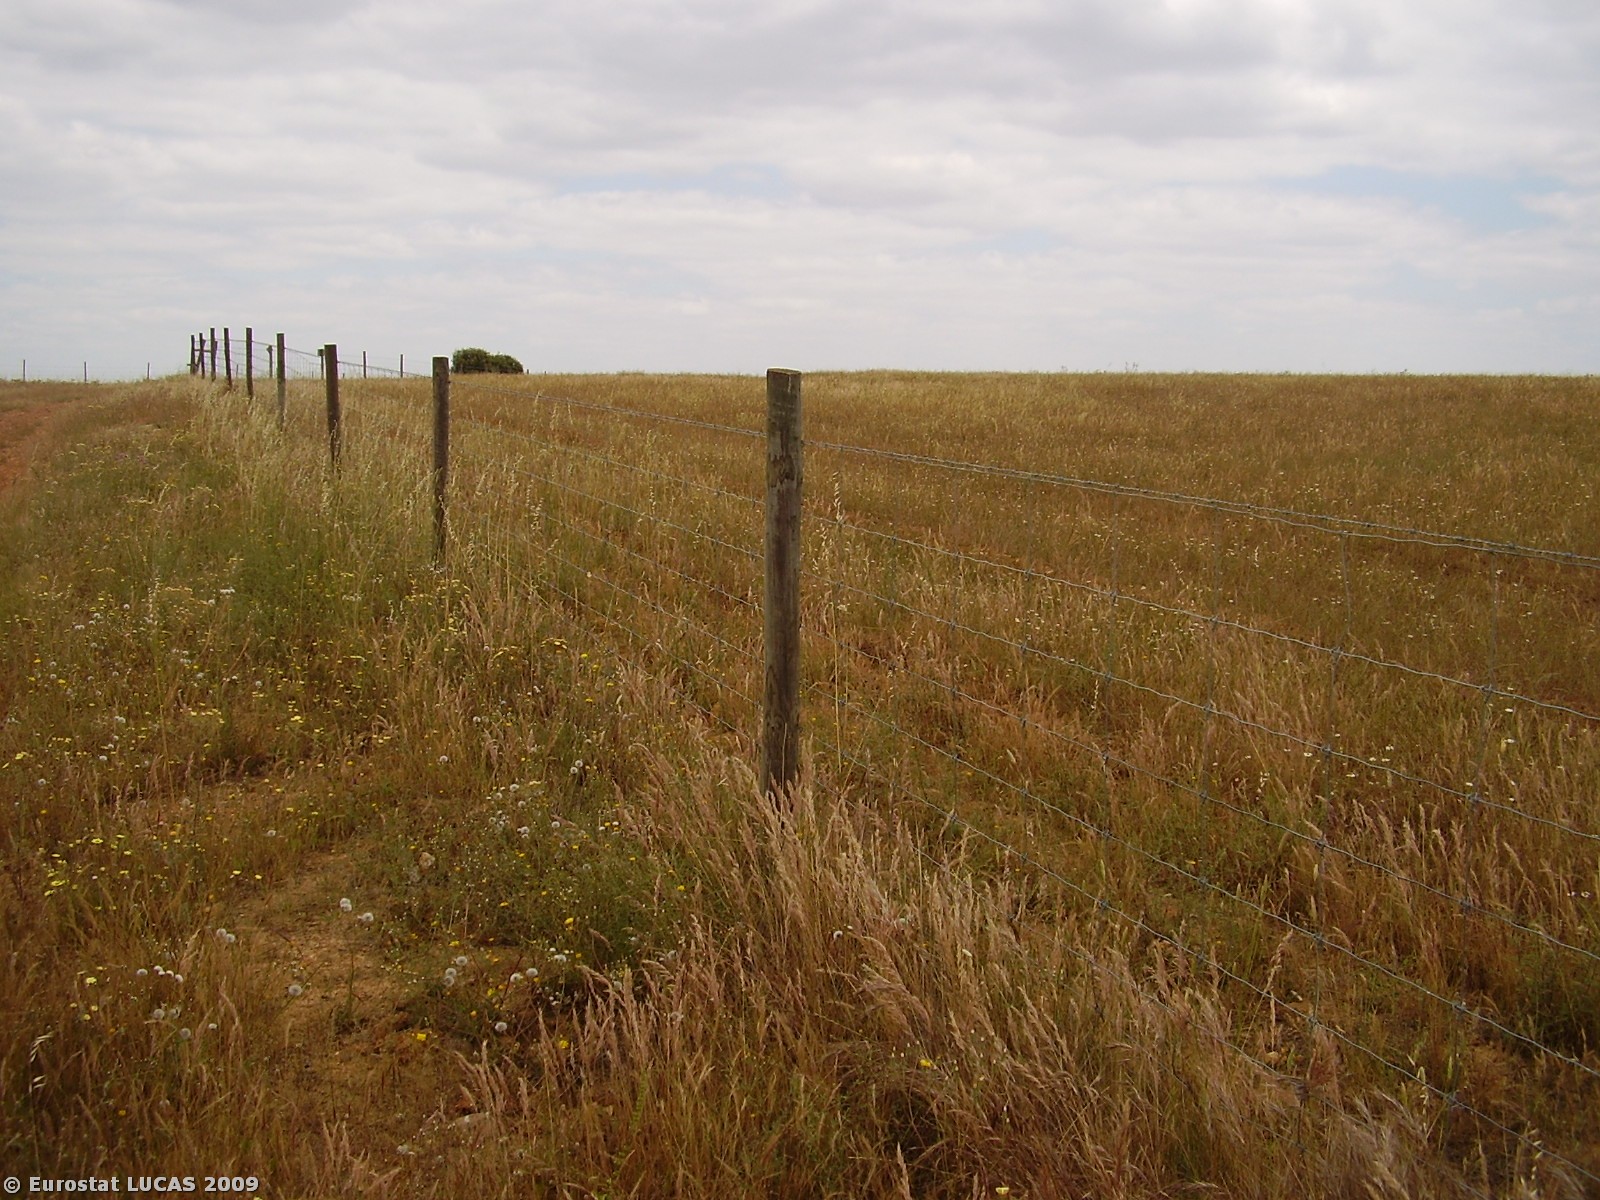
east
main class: Grassland
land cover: Grassland without tree/shrub cover
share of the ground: > 75 %
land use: Agriculture (excluding fallow land and kitchen gardens)
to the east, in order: Grassland without tree/shrub cover
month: May
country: PT
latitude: 37.7596
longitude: -7.8780
